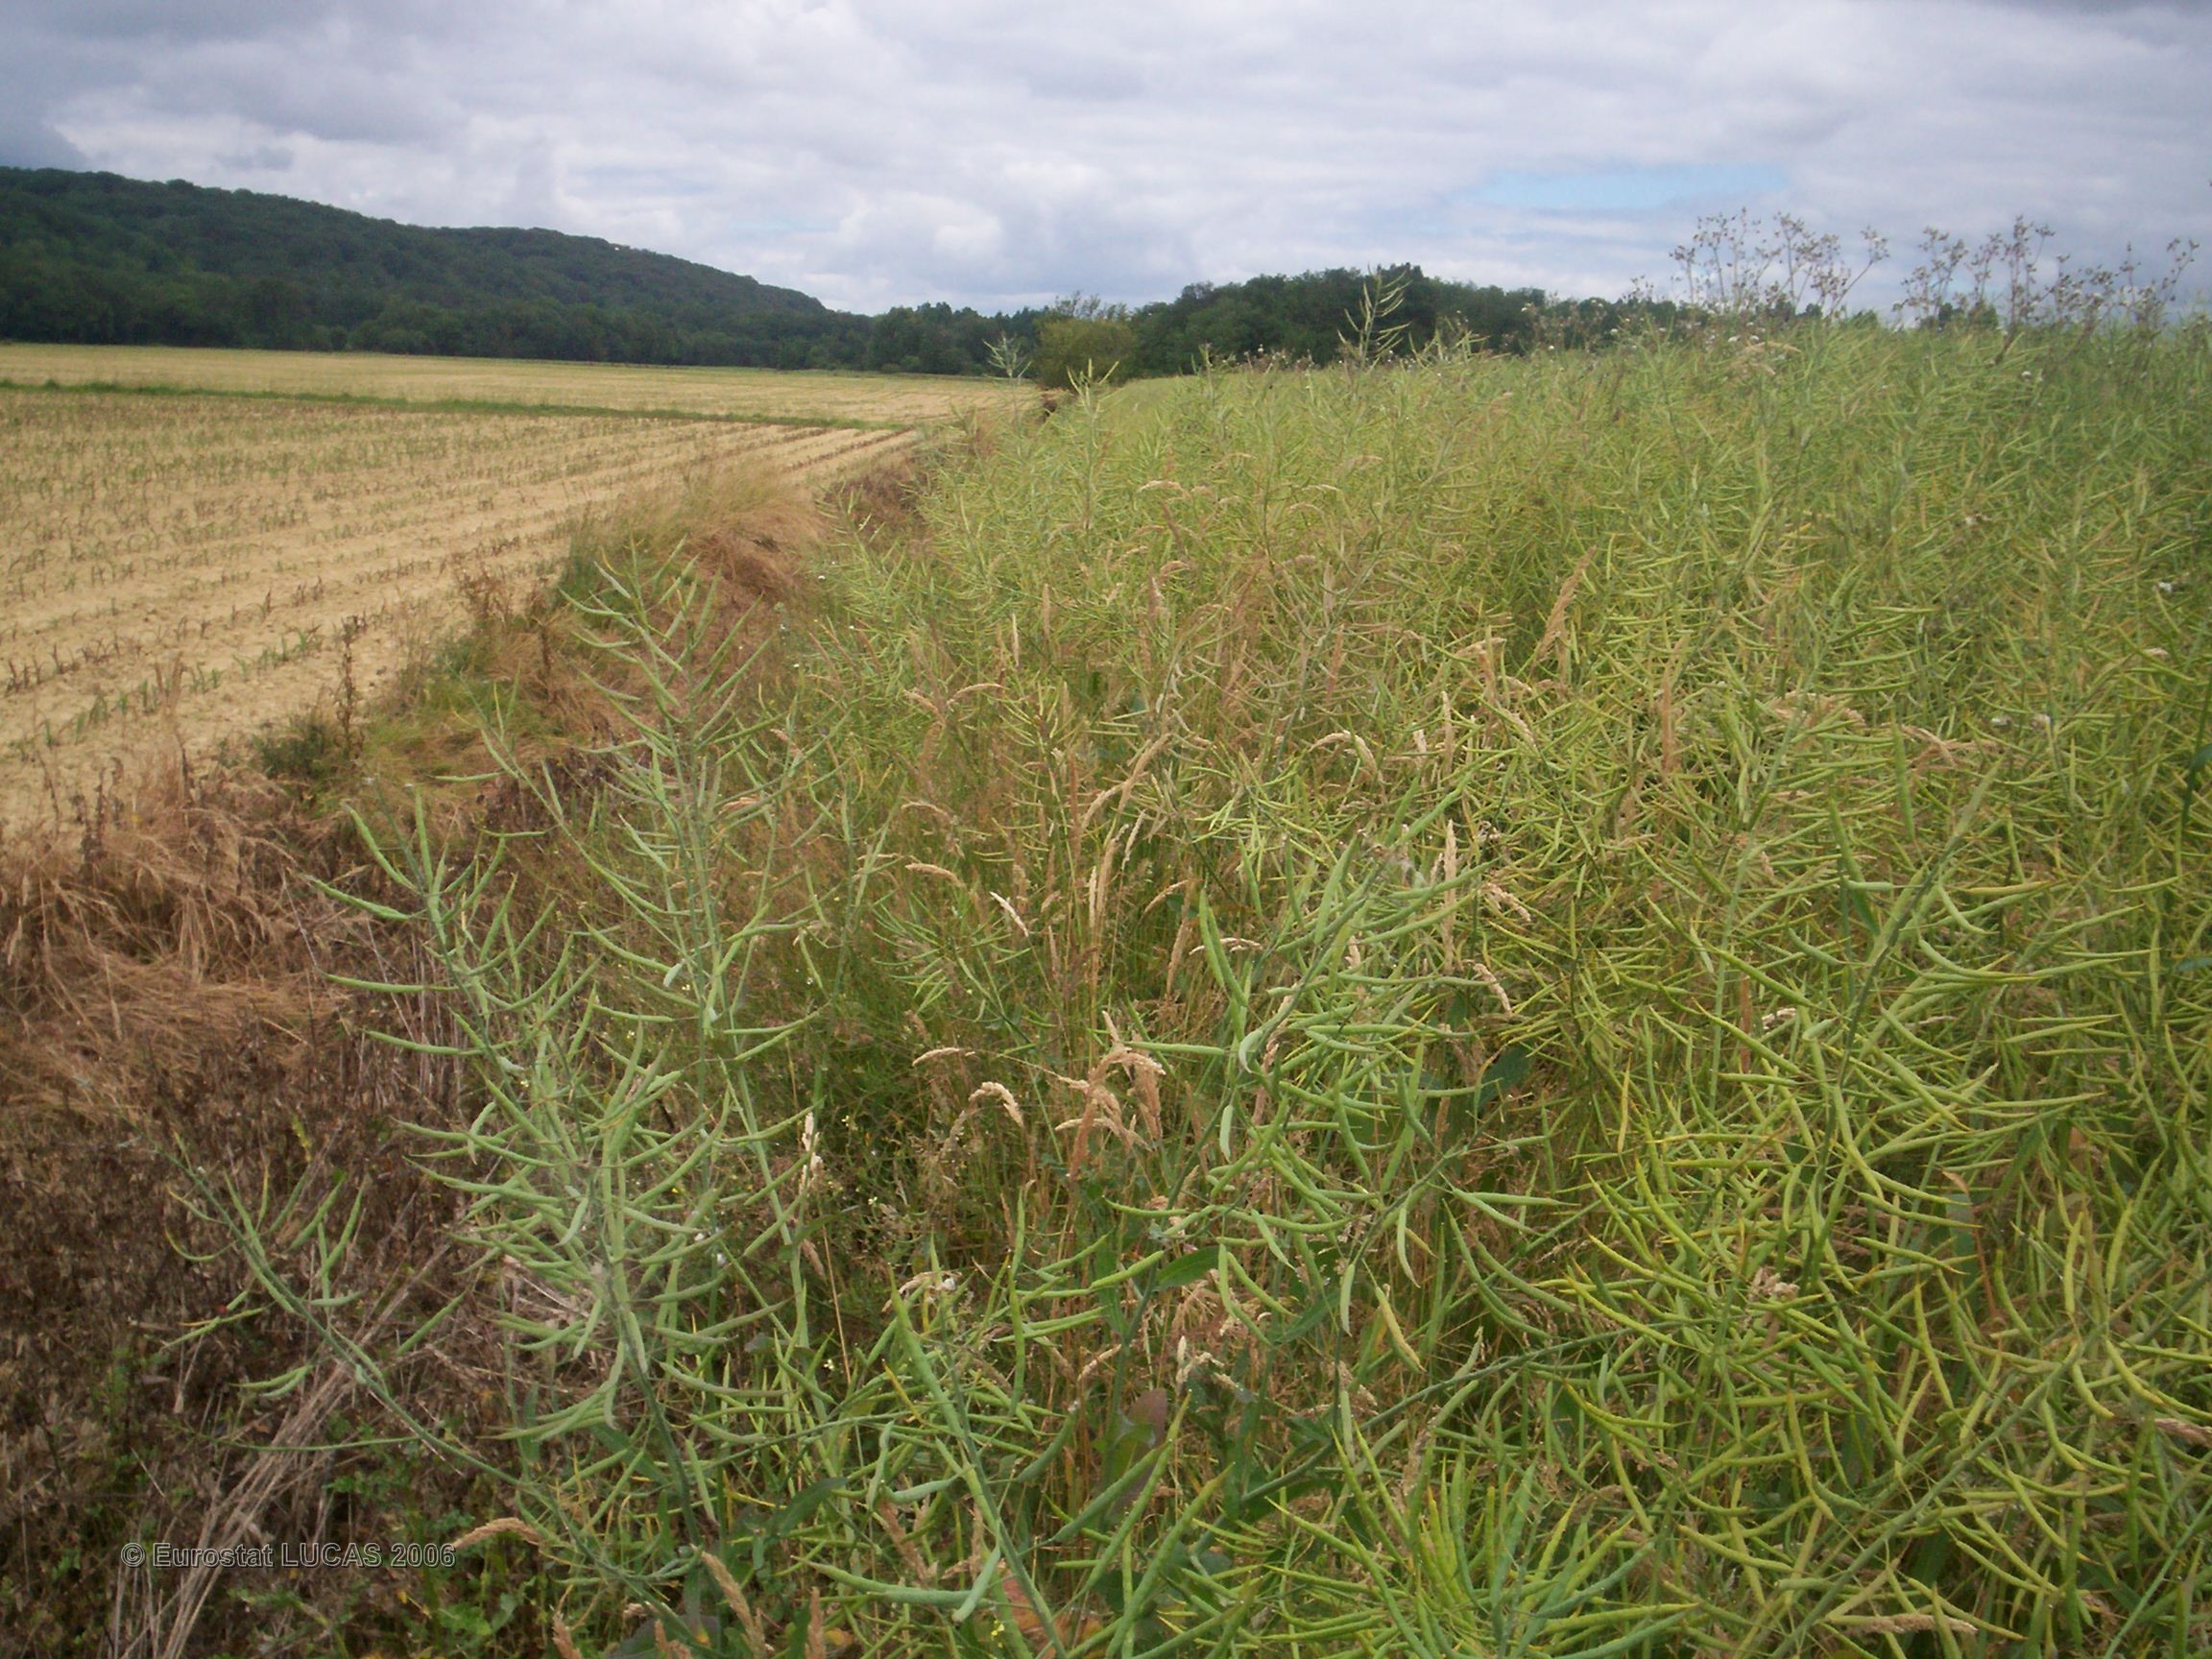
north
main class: Cropland
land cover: Rape and turnip rape
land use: Agriculture (excluding fallow land and kitchen gardens)
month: May
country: FR
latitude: 43.6611
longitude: -0.2386
